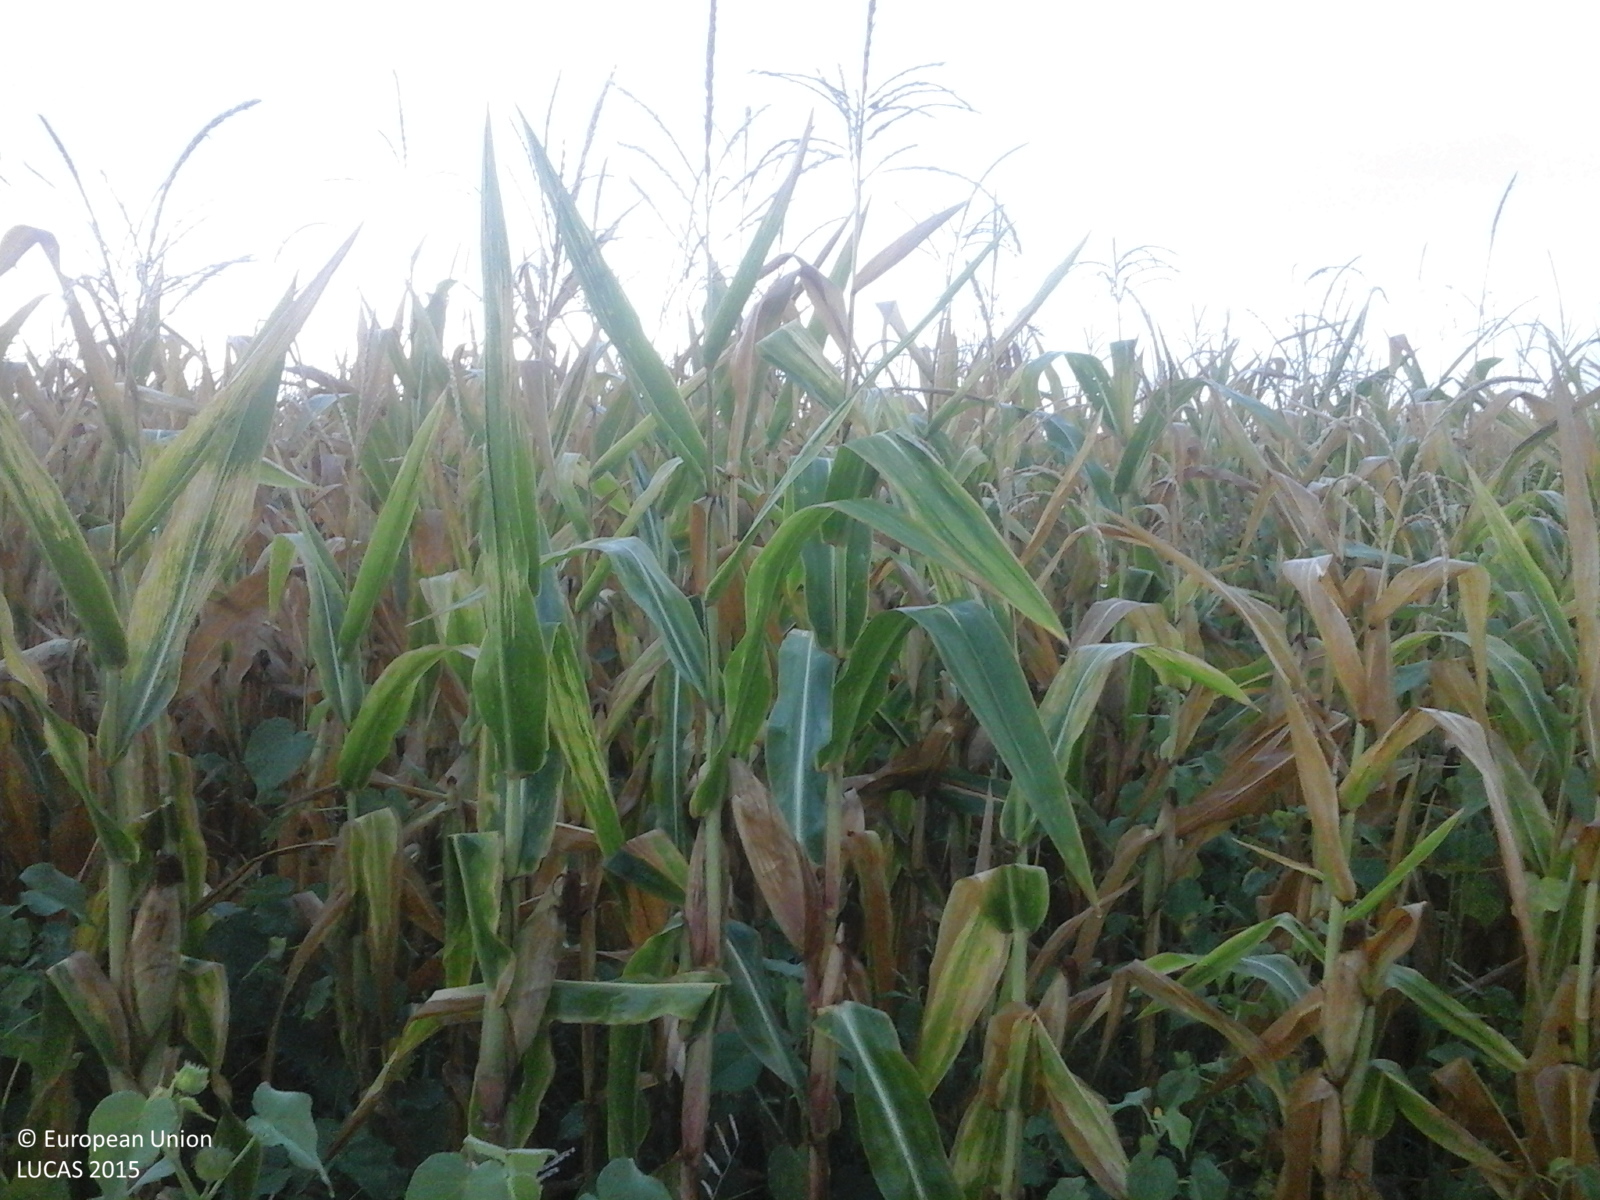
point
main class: Cropland
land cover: Maize
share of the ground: > 75 %
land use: Agriculture (excluding fallow land and kitchen gardens)
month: August
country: RO
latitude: 45.6264
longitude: 21.0976
